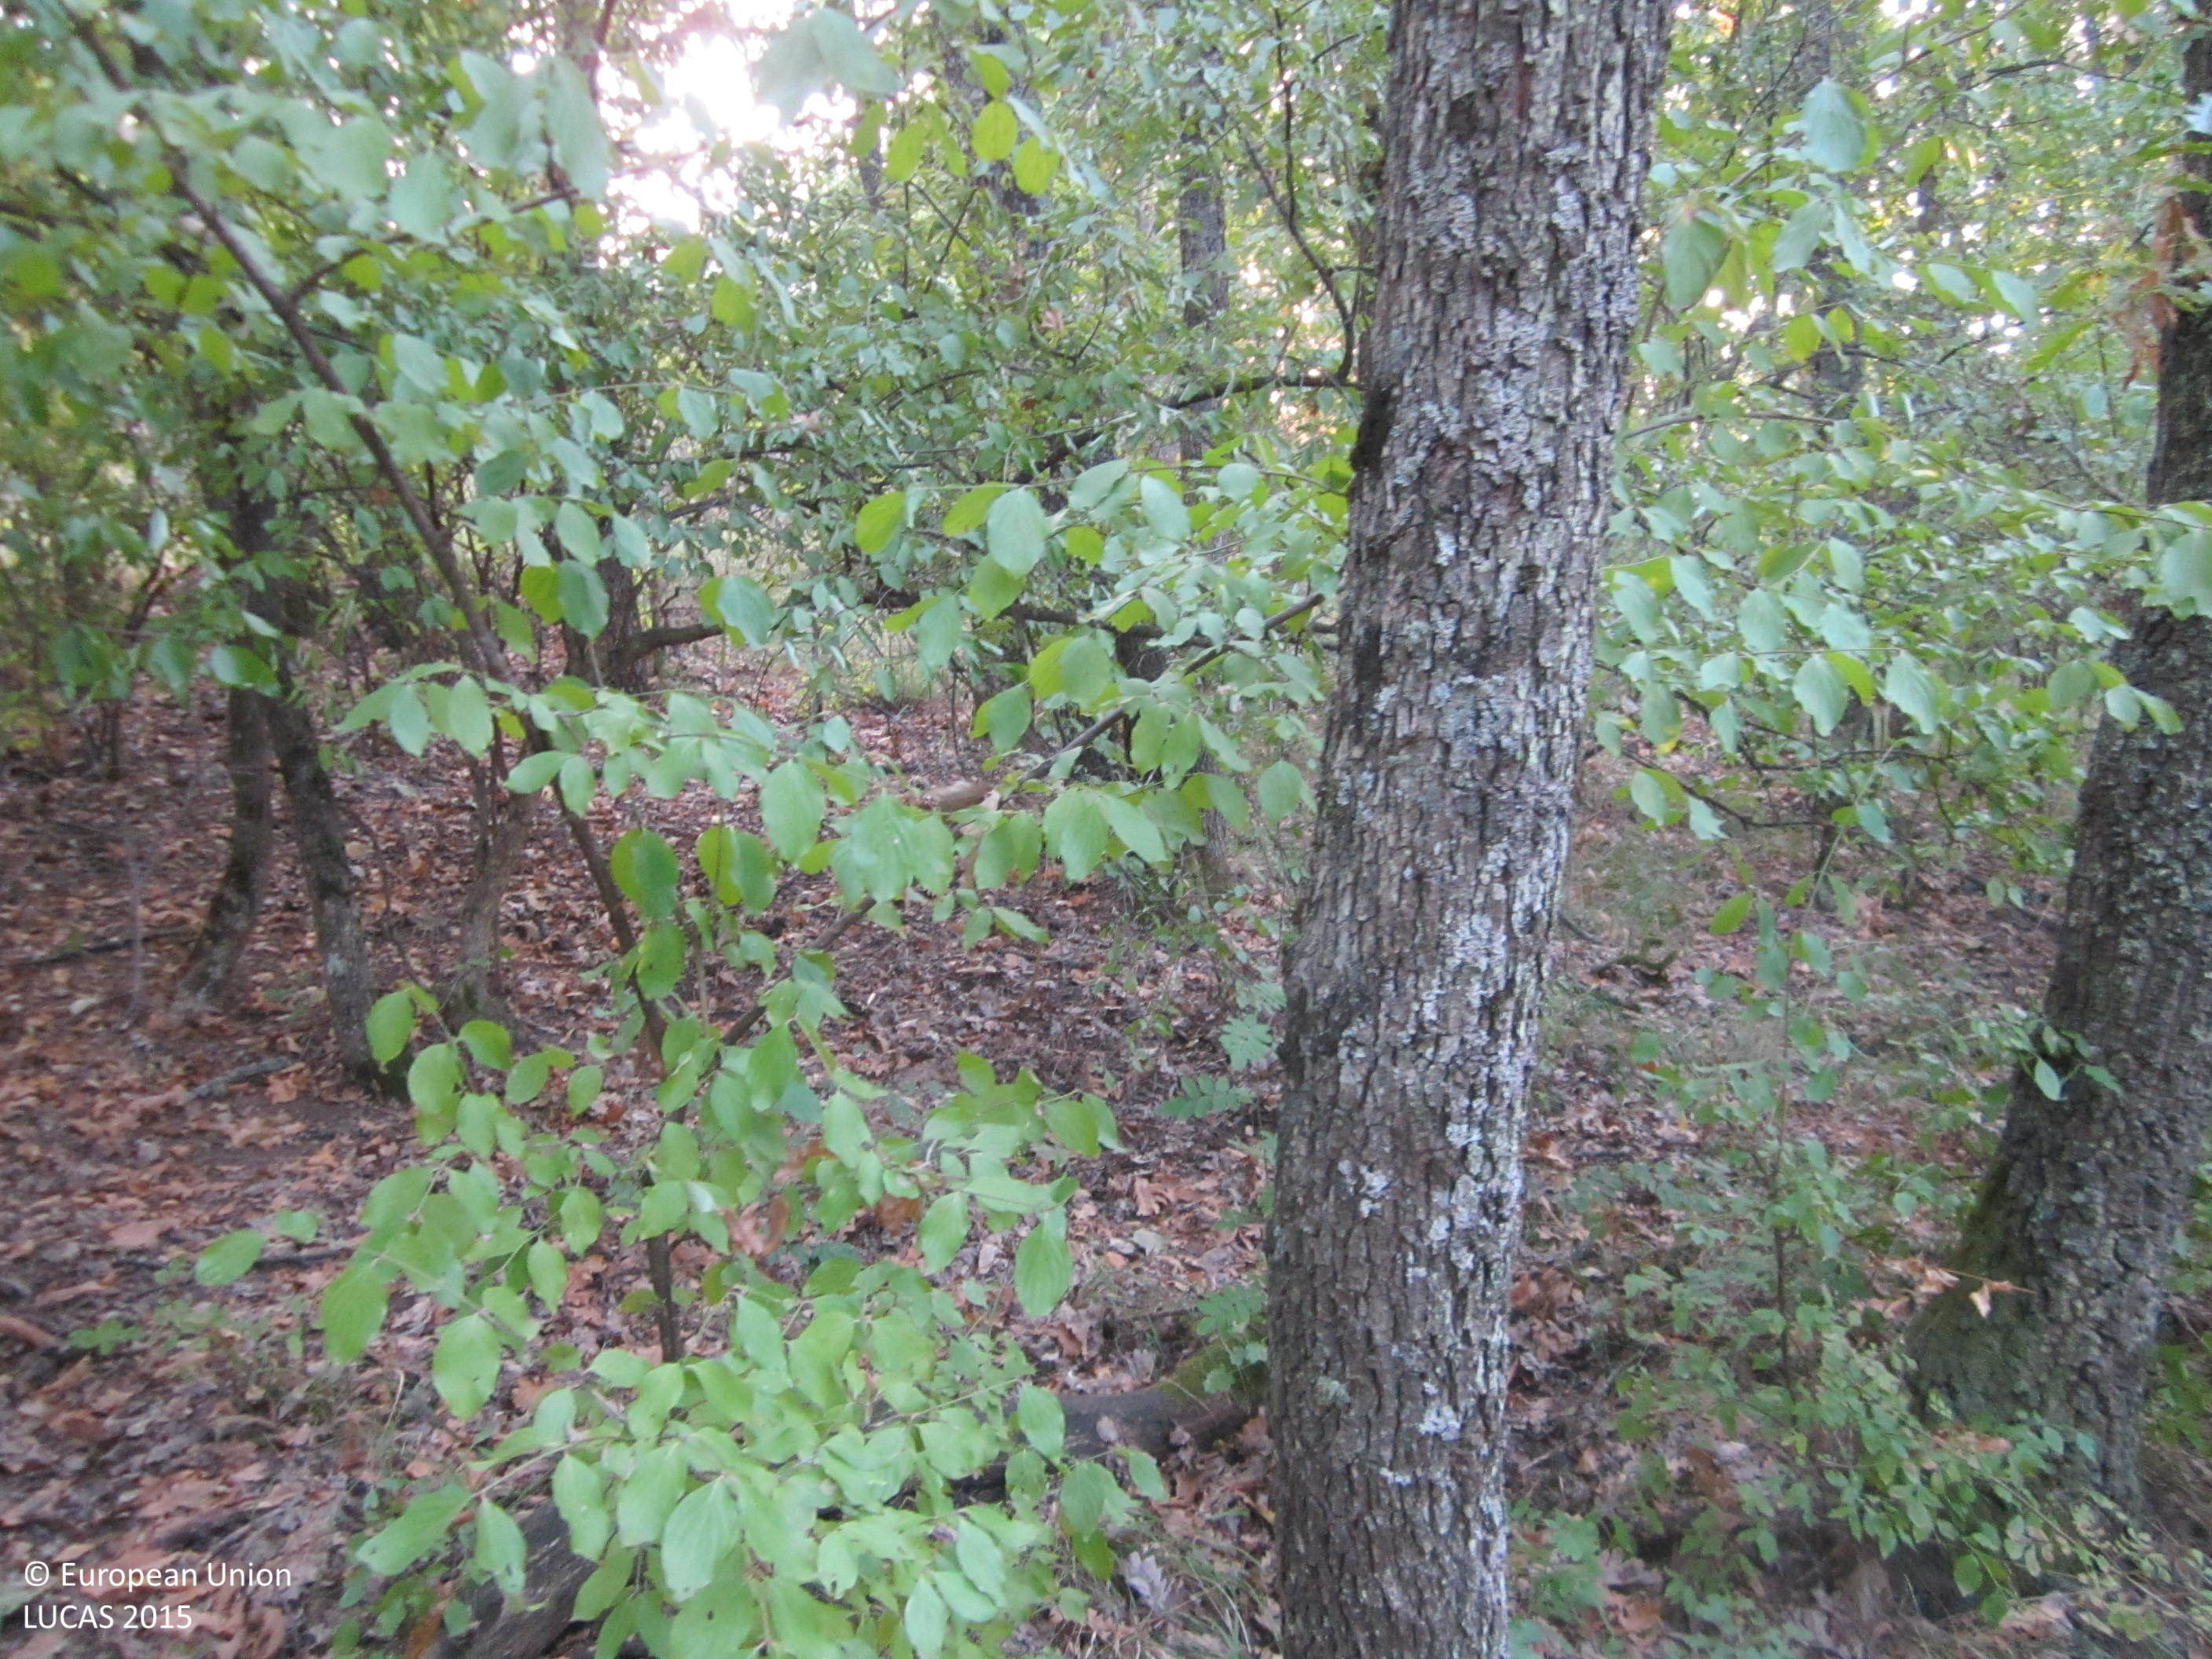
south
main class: Woodland
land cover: Broadleaved woodland
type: thermophilous deciduous forest
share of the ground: > 75 %
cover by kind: broadleaved forest trees 80 %, herbaceous plants 10 %, unconsolidated bare surface 10 %
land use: Forestry
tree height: > 5 m
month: September
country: BG
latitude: 42.2402
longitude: 27.0812
